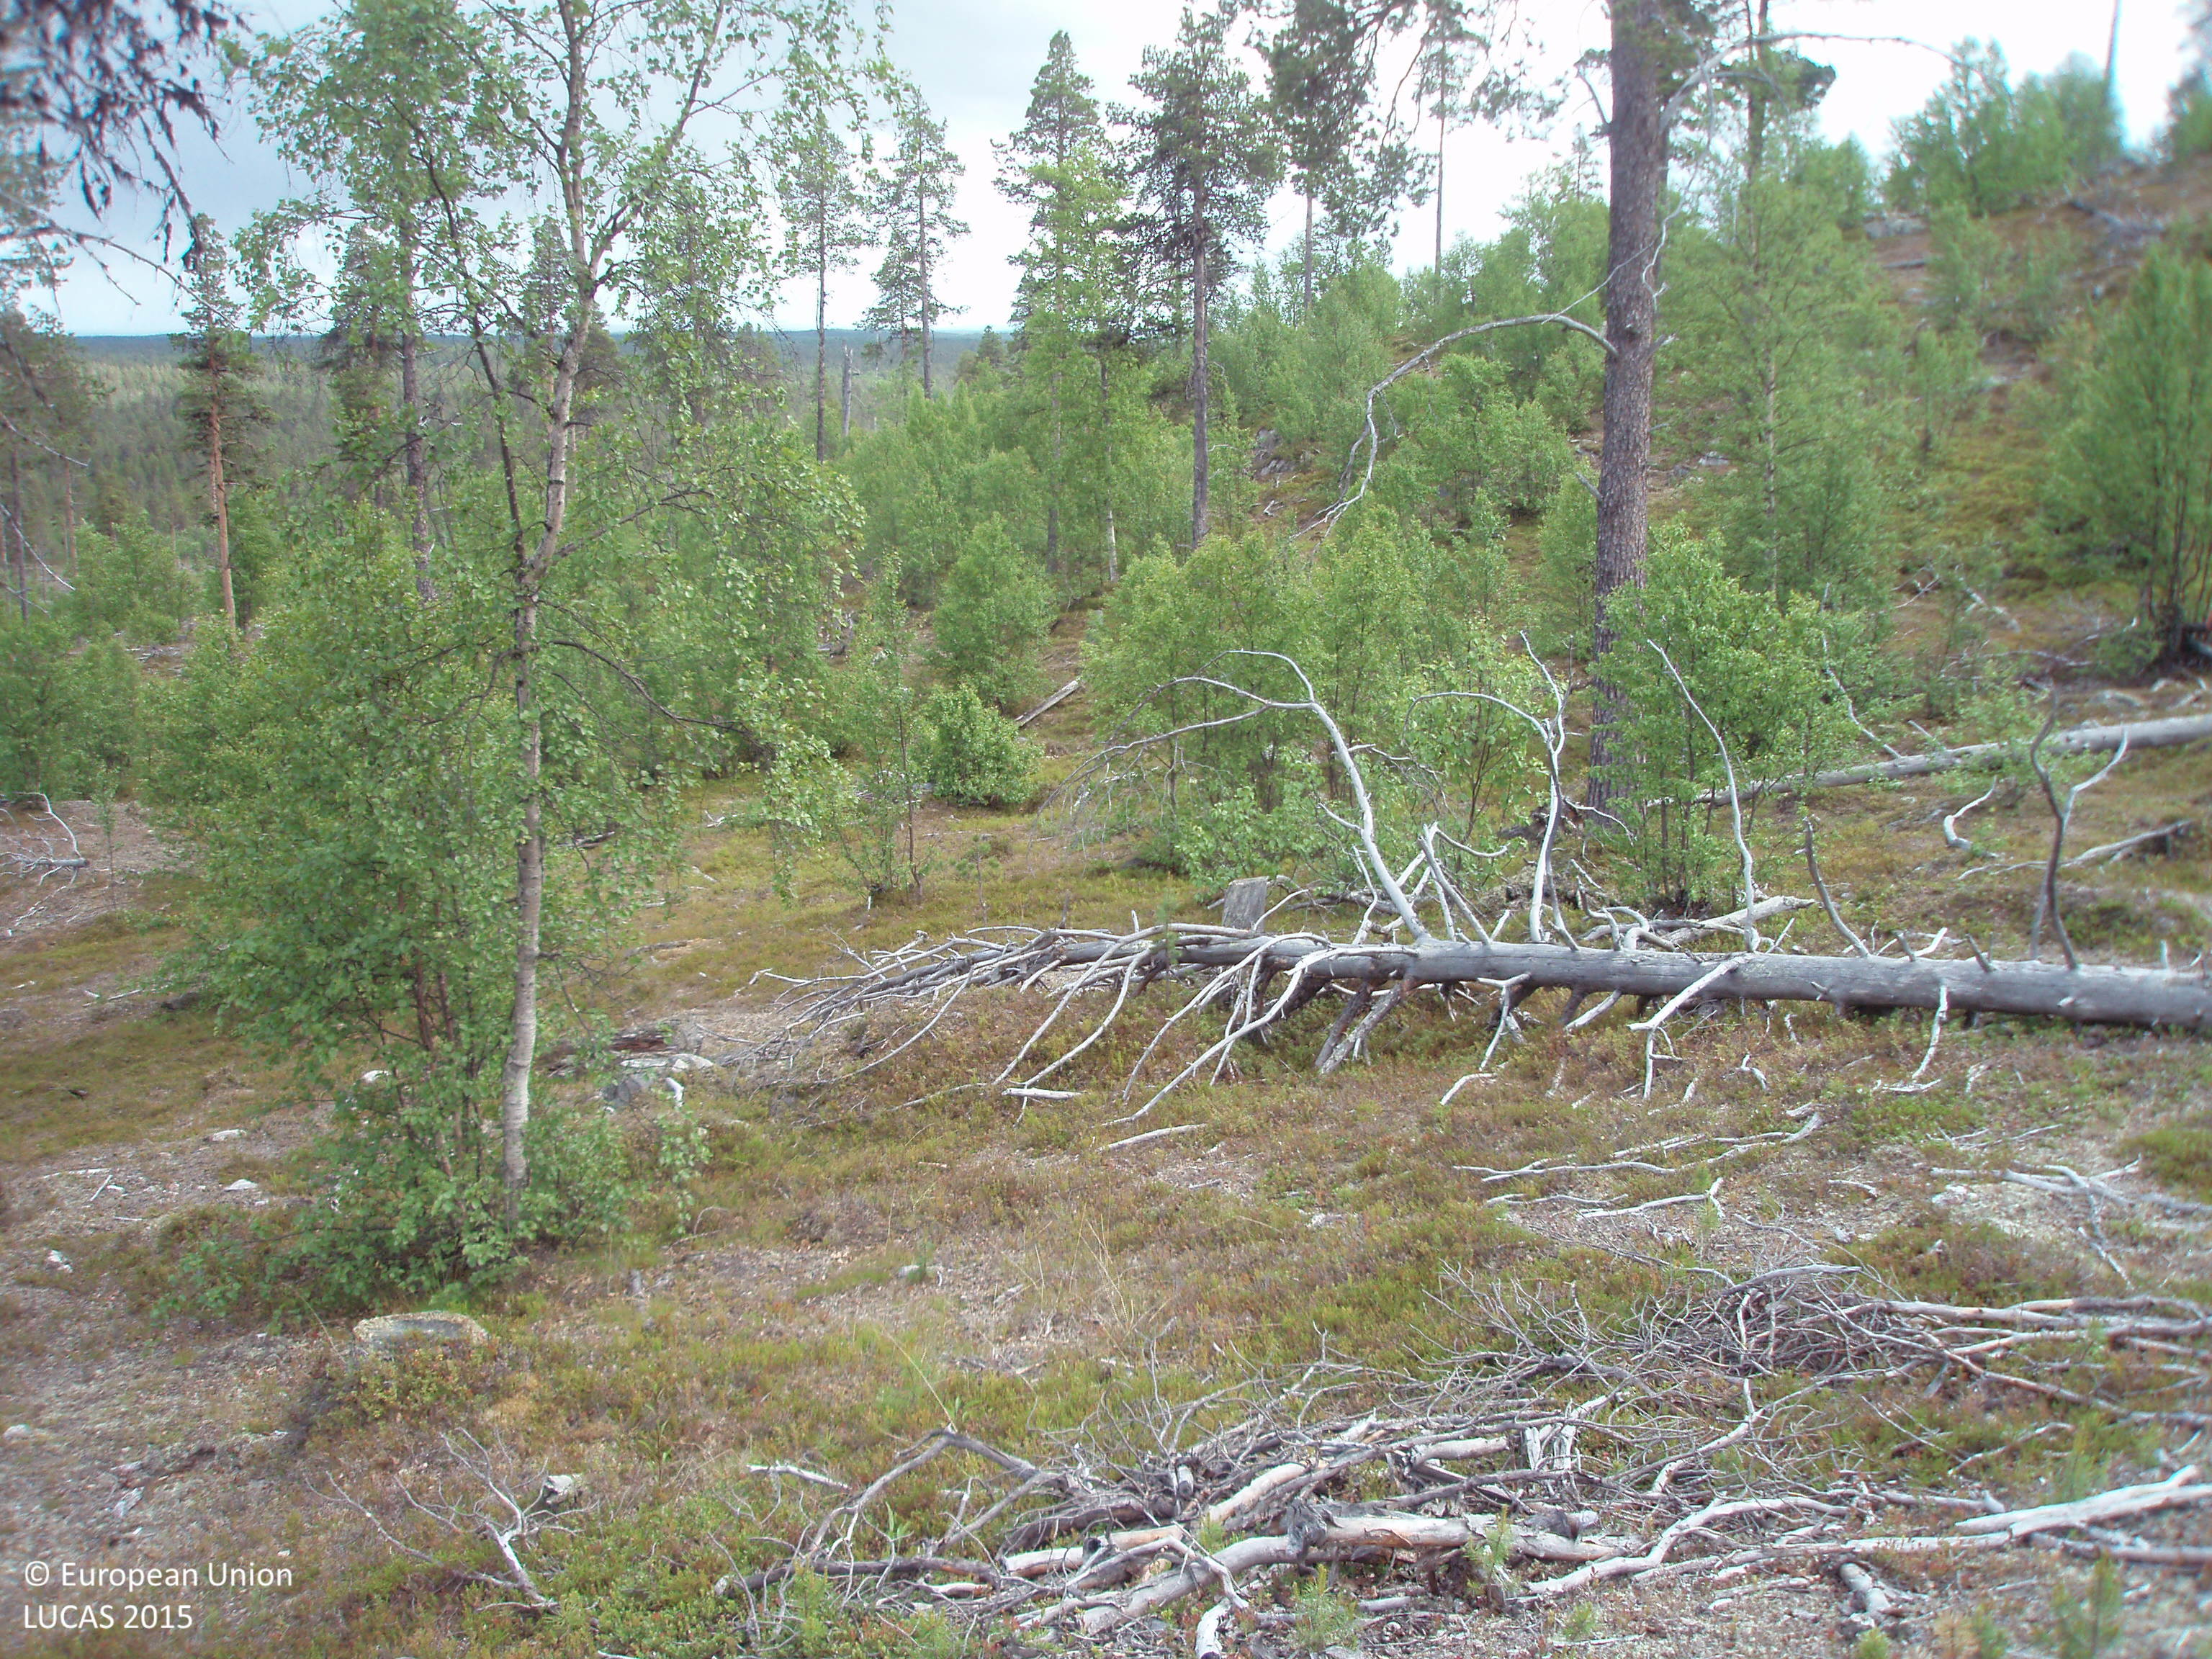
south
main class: Woodland
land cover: Pine dominated mixed woodland
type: boreal forest
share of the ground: 10 - 25 %
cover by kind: lichens and mosses 60 %, shrubs 25 %, coniferous forest trees 10 %, broadleaved forest trees 5 %
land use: Forestry
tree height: > 5 m
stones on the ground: < 10 %
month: July
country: FI
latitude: 69.2223
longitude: 27.8848
